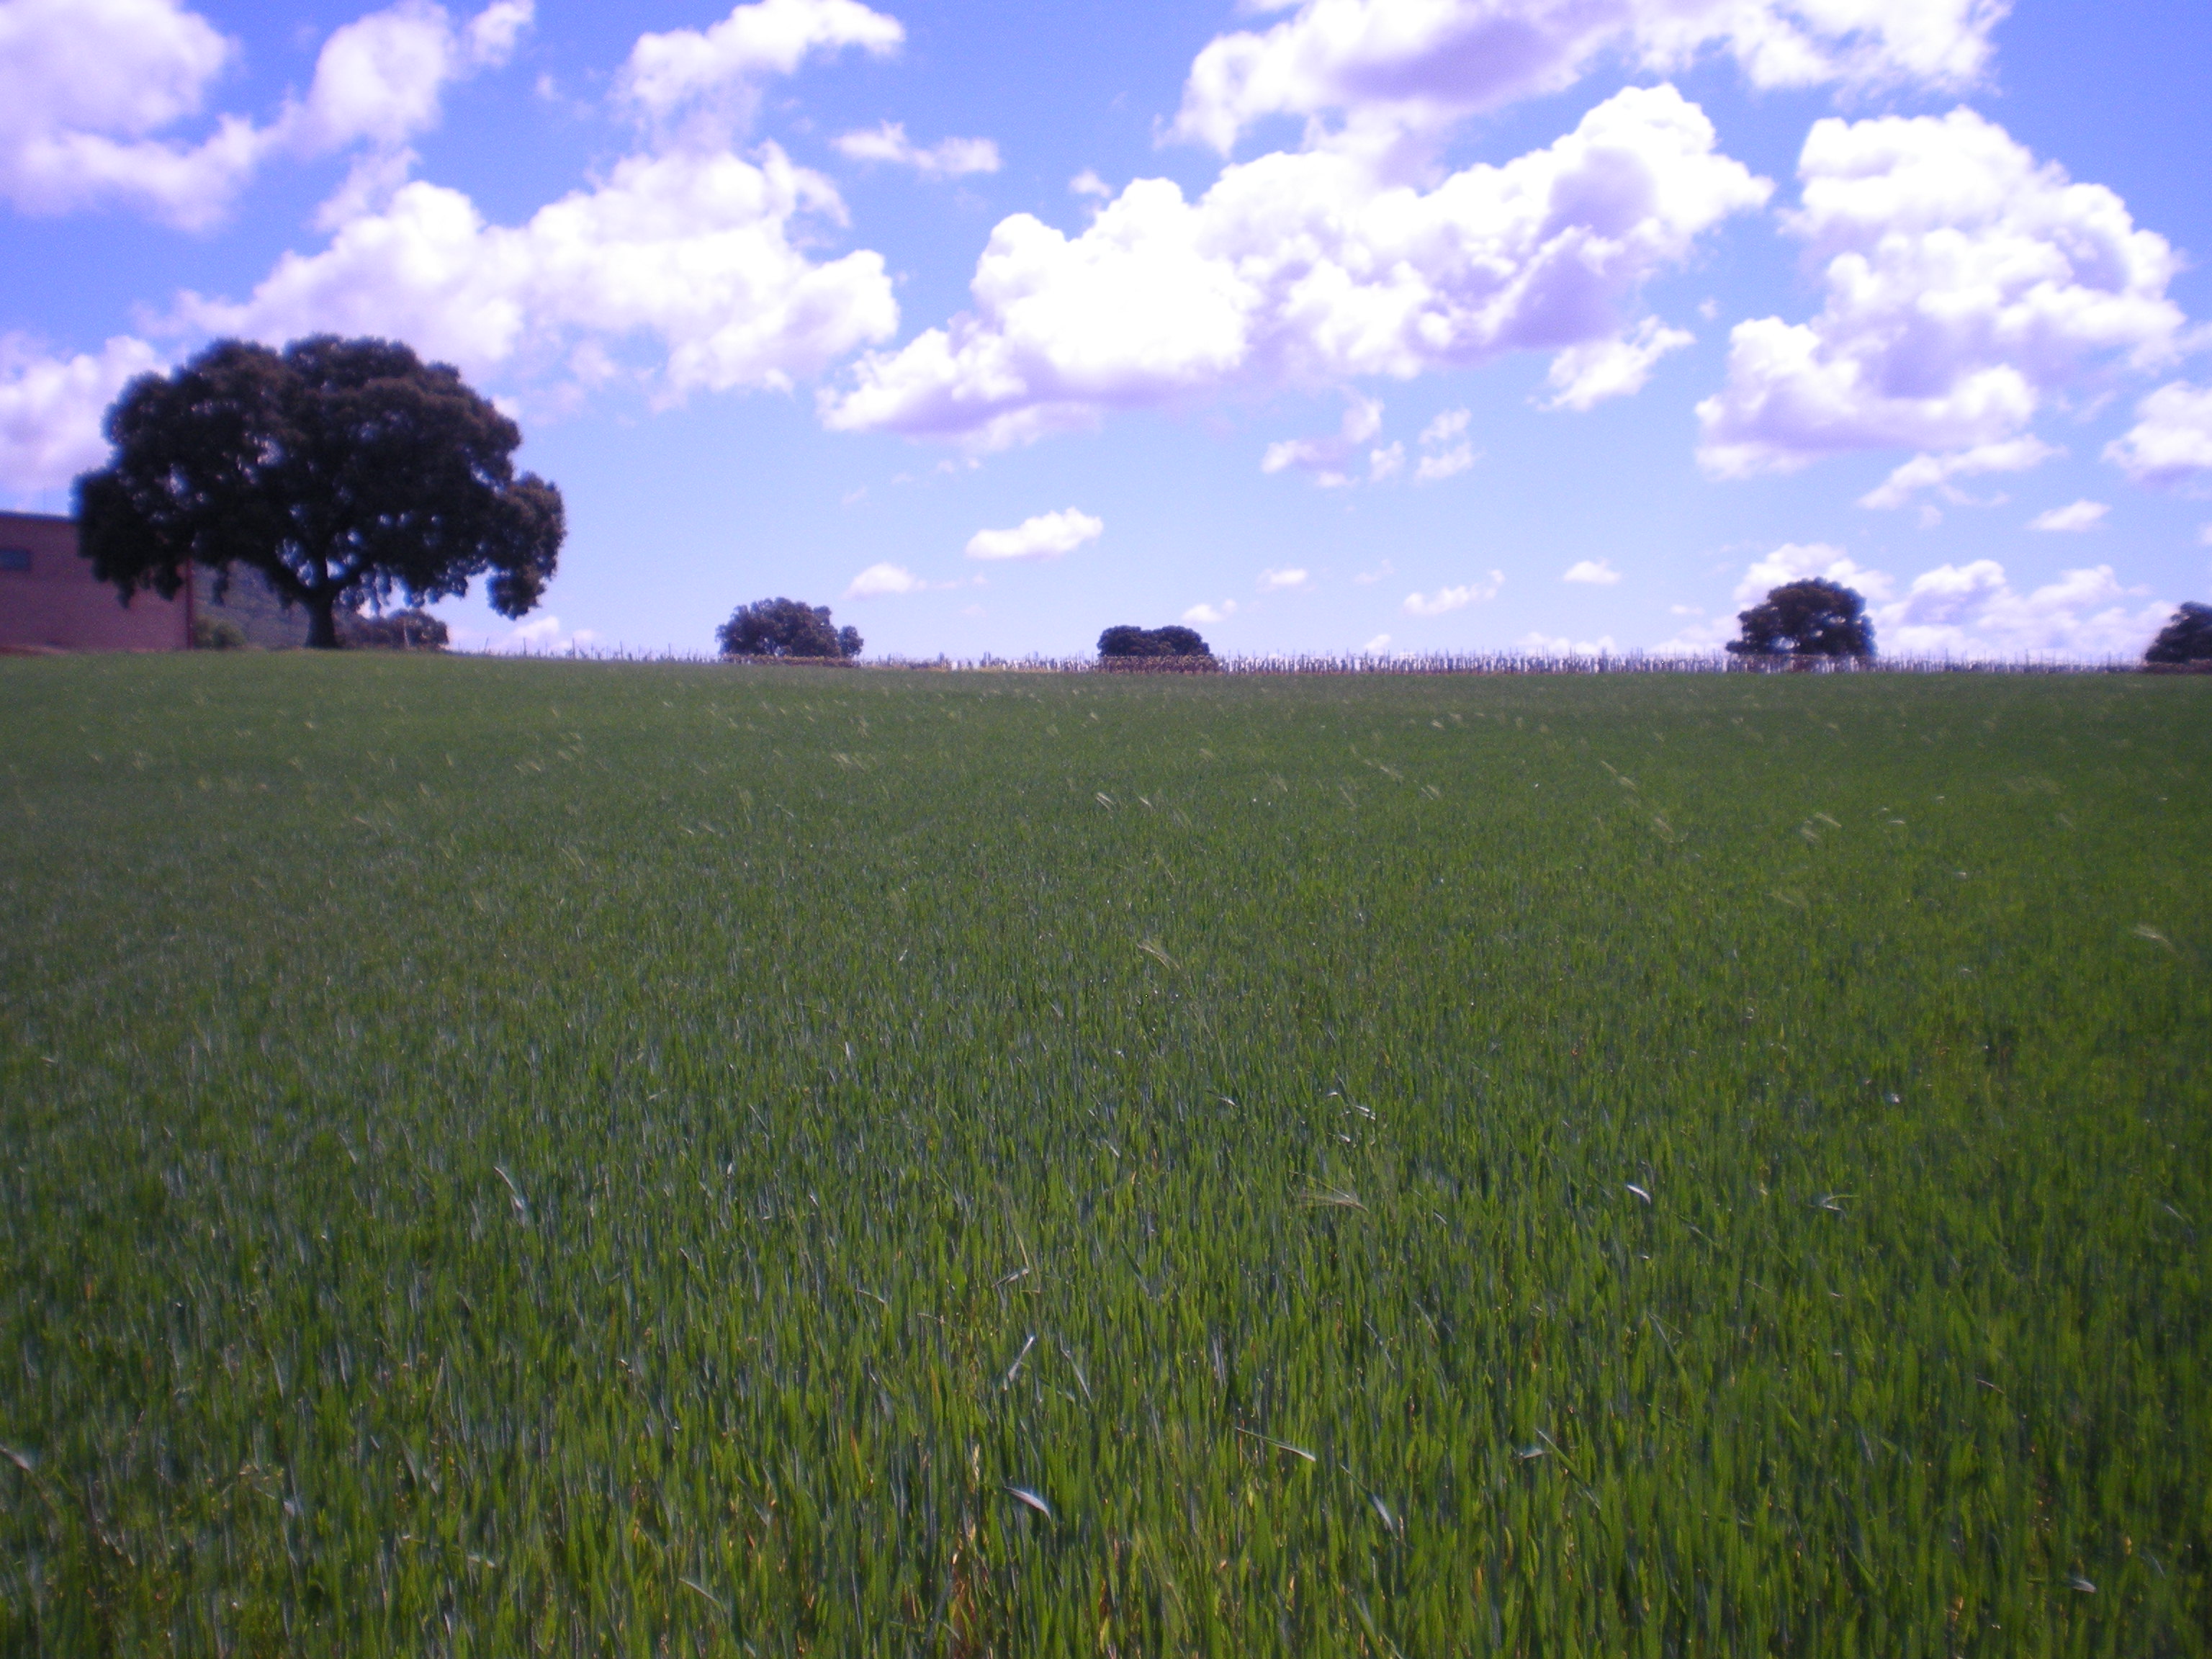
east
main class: Cropland
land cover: Durum wheat
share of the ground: > 75 %
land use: Agriculture (excluding fallow land and kitchen gardens)
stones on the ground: 10 - 25 %
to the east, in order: Durum wheat; Grass margins; Tracks; Grass margins; Vineyards; Grass margins; Tracks; Grass margins; Vineyards
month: April
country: ES
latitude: 38.5483
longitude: -3.1896
